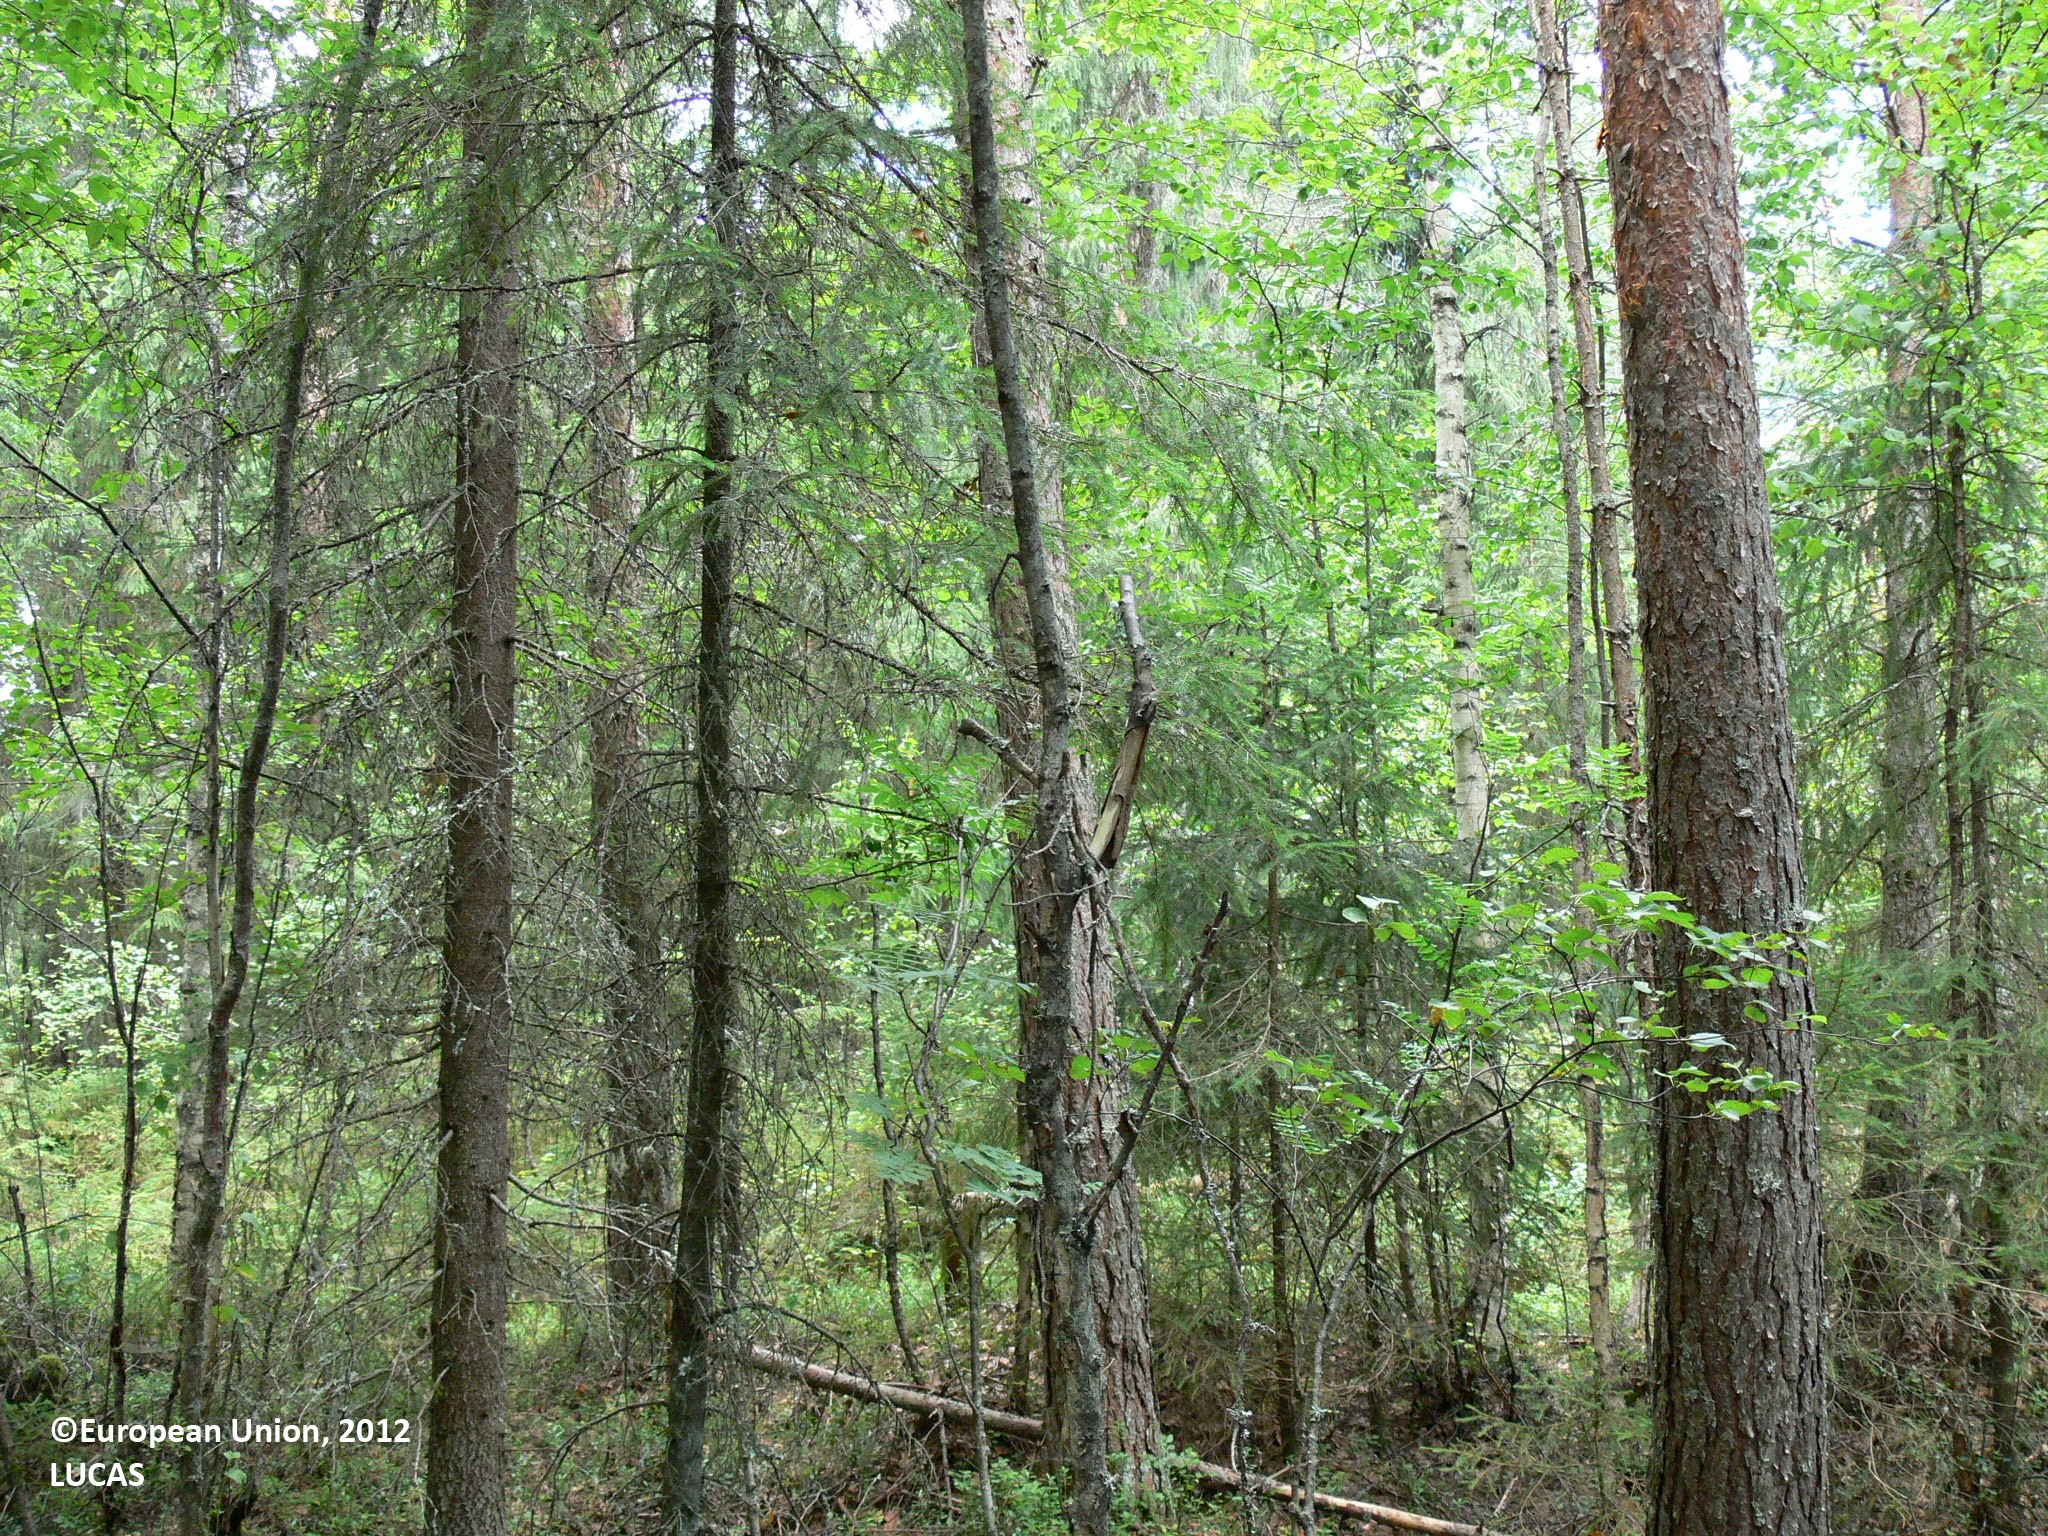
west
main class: Woodland
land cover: Other coniferous woodland
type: boreal forest
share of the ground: > 75 %
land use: Forestry
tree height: > 5 m
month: August
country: FI
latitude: 62.0420
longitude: 29.3791
